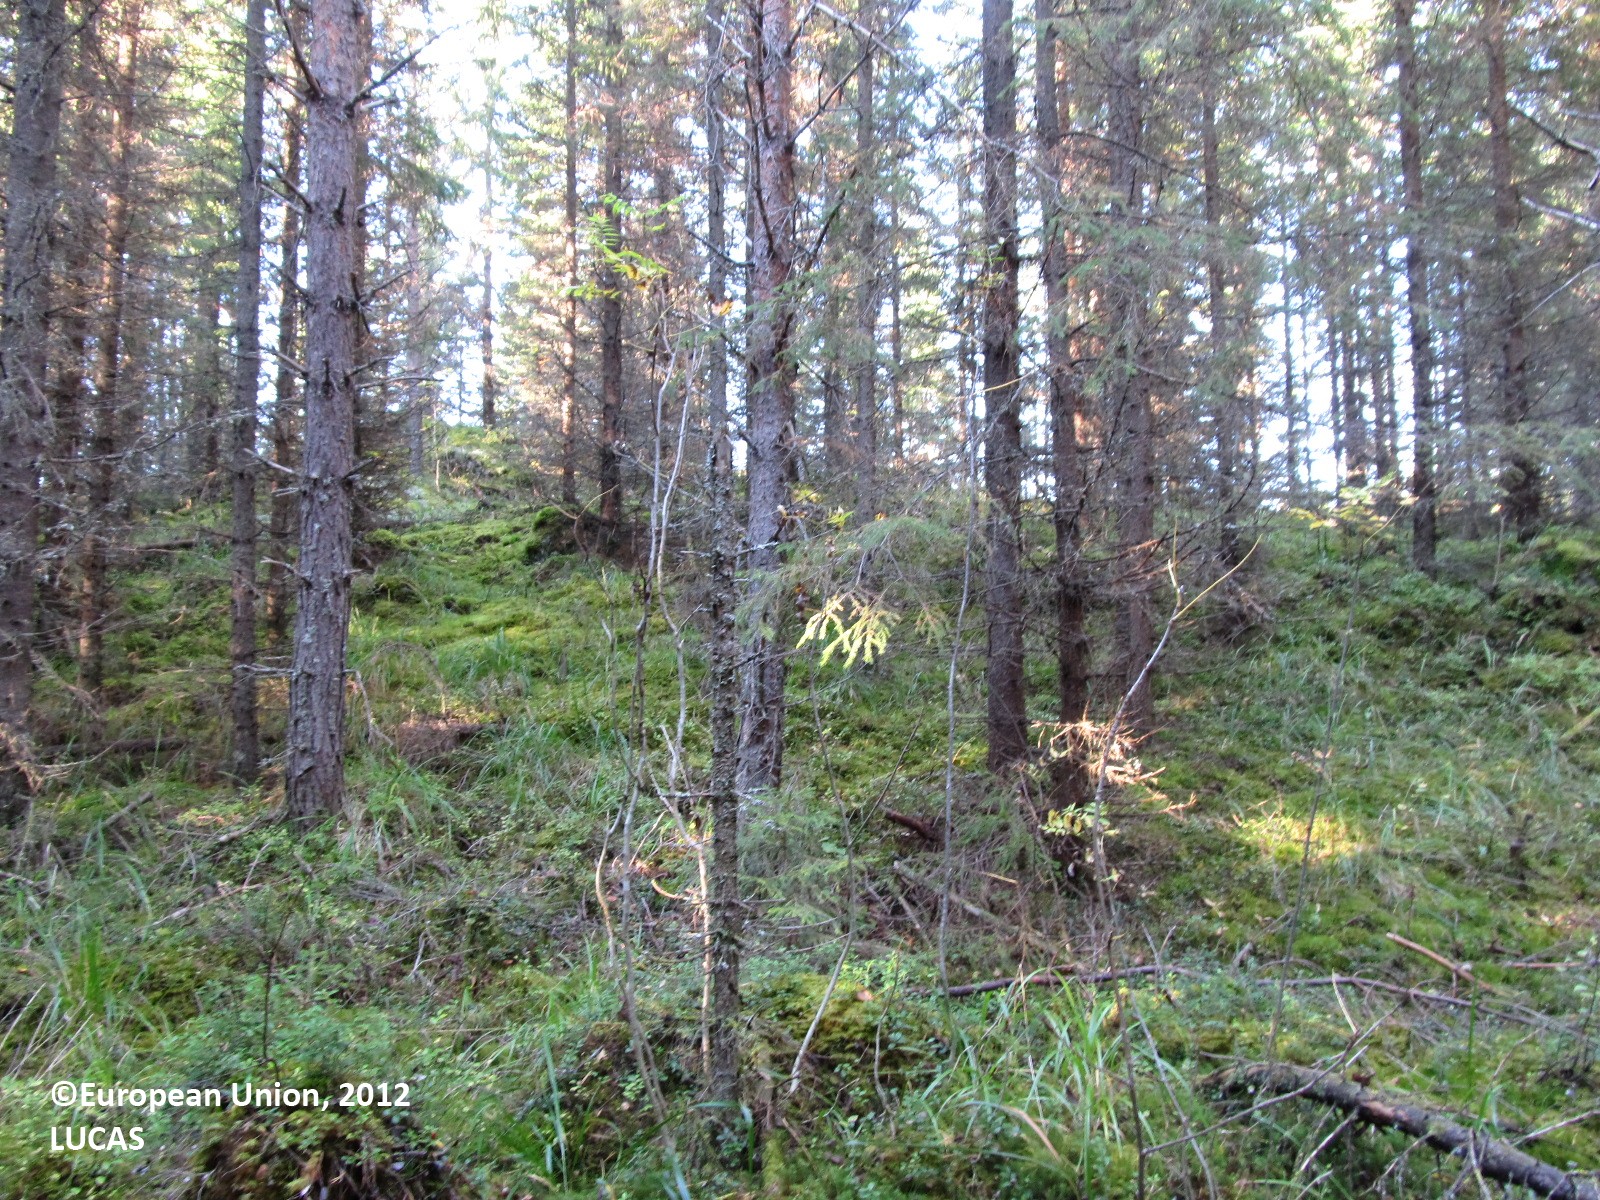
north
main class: Woodland
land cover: Pine dominated coniferous woodland
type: boreal forest
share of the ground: 50 - 75 %
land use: Forestry
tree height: > 5 m
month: September
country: FI
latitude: 62.3973
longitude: 28.3635
